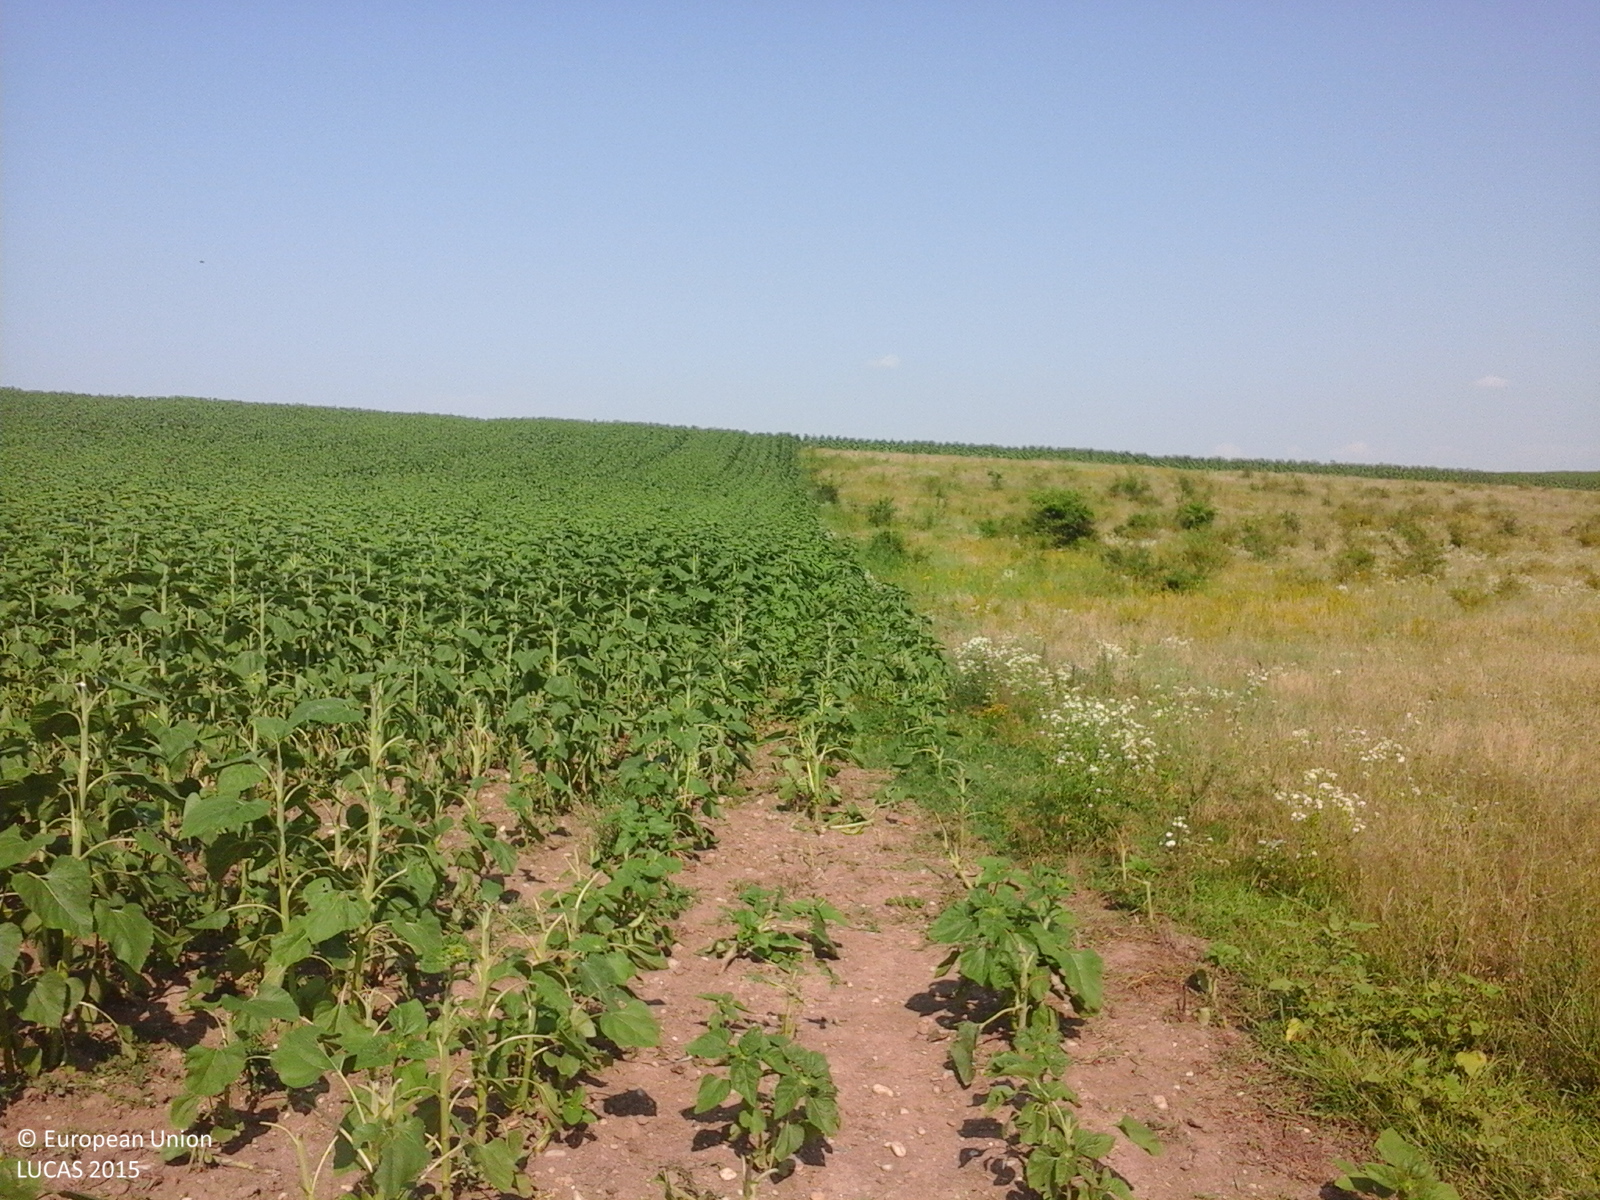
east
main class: Cropland
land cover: Sunflower
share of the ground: > 75 %
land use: Agriculture (excluding fallow land and kitchen gardens)
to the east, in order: Sunflower
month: July
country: RO
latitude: 44.6387
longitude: 24.5330
